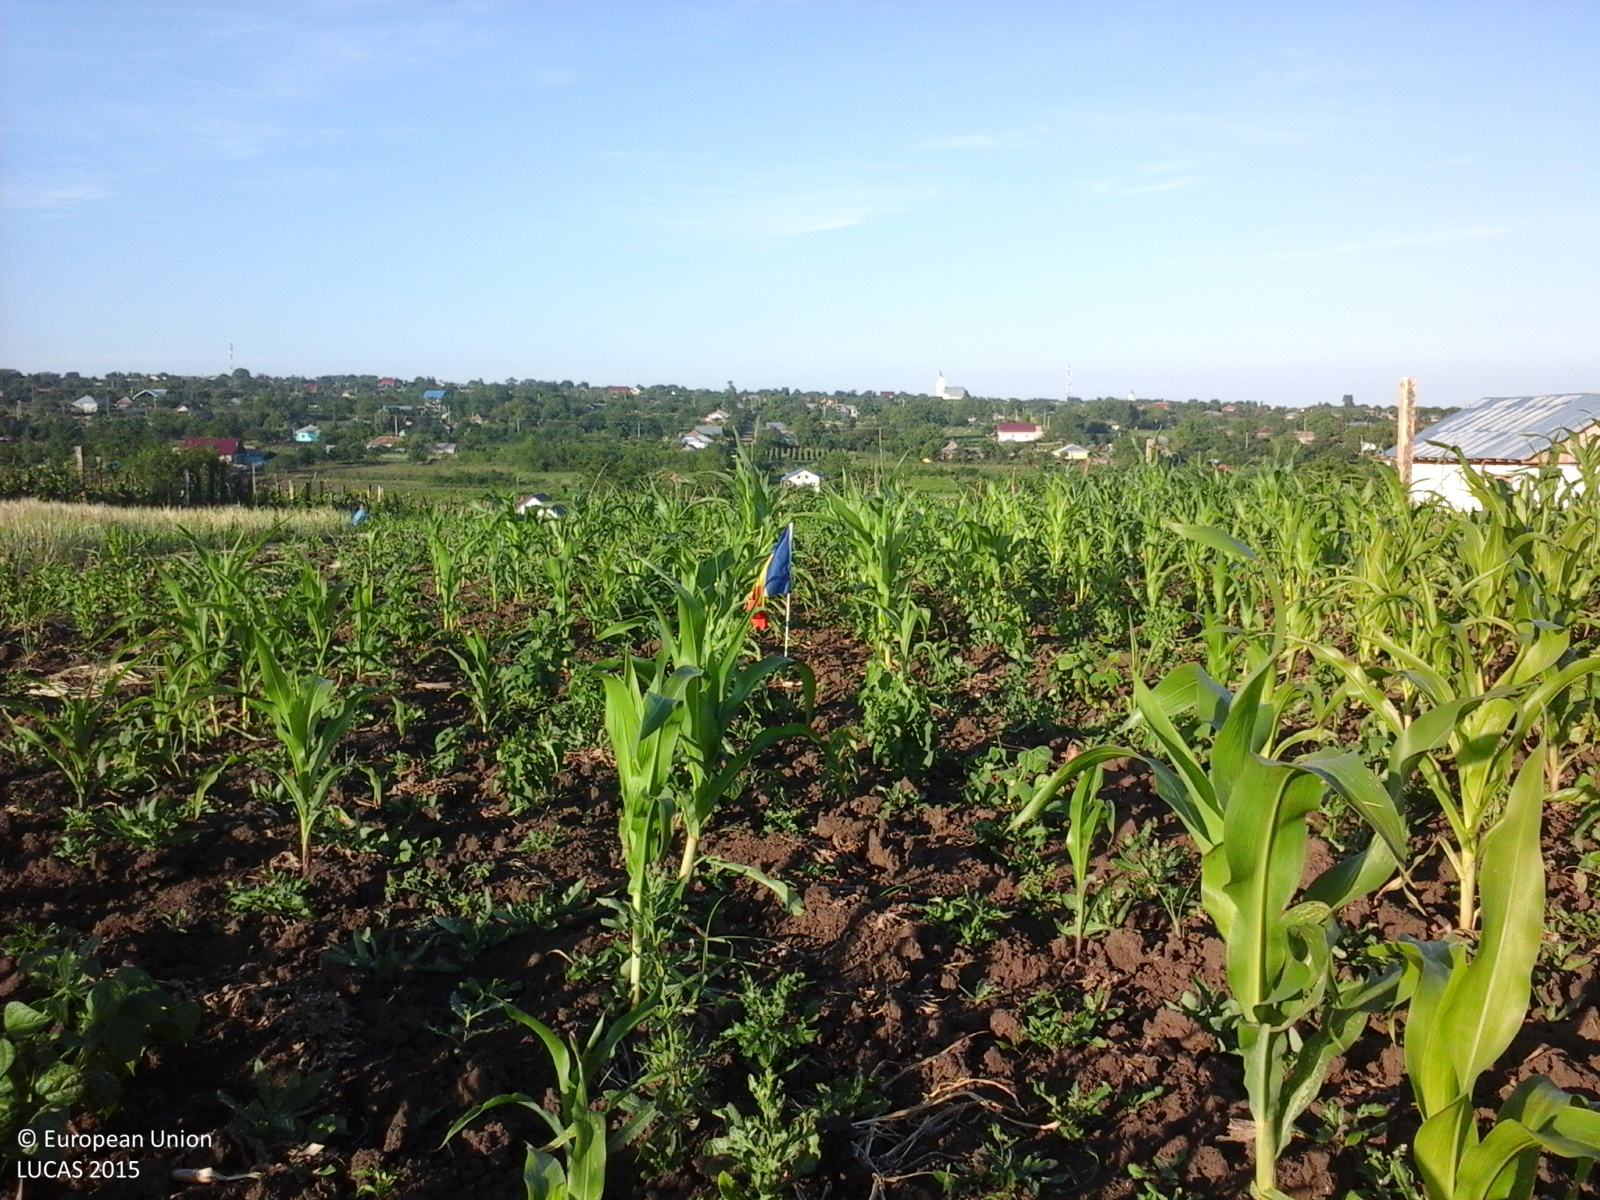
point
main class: Cropland
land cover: Maize
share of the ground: > 75 %
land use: Agriculture (excluding fallow land and kitchen gardens)
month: June
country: RO
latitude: 47.3190
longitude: 27.0782
